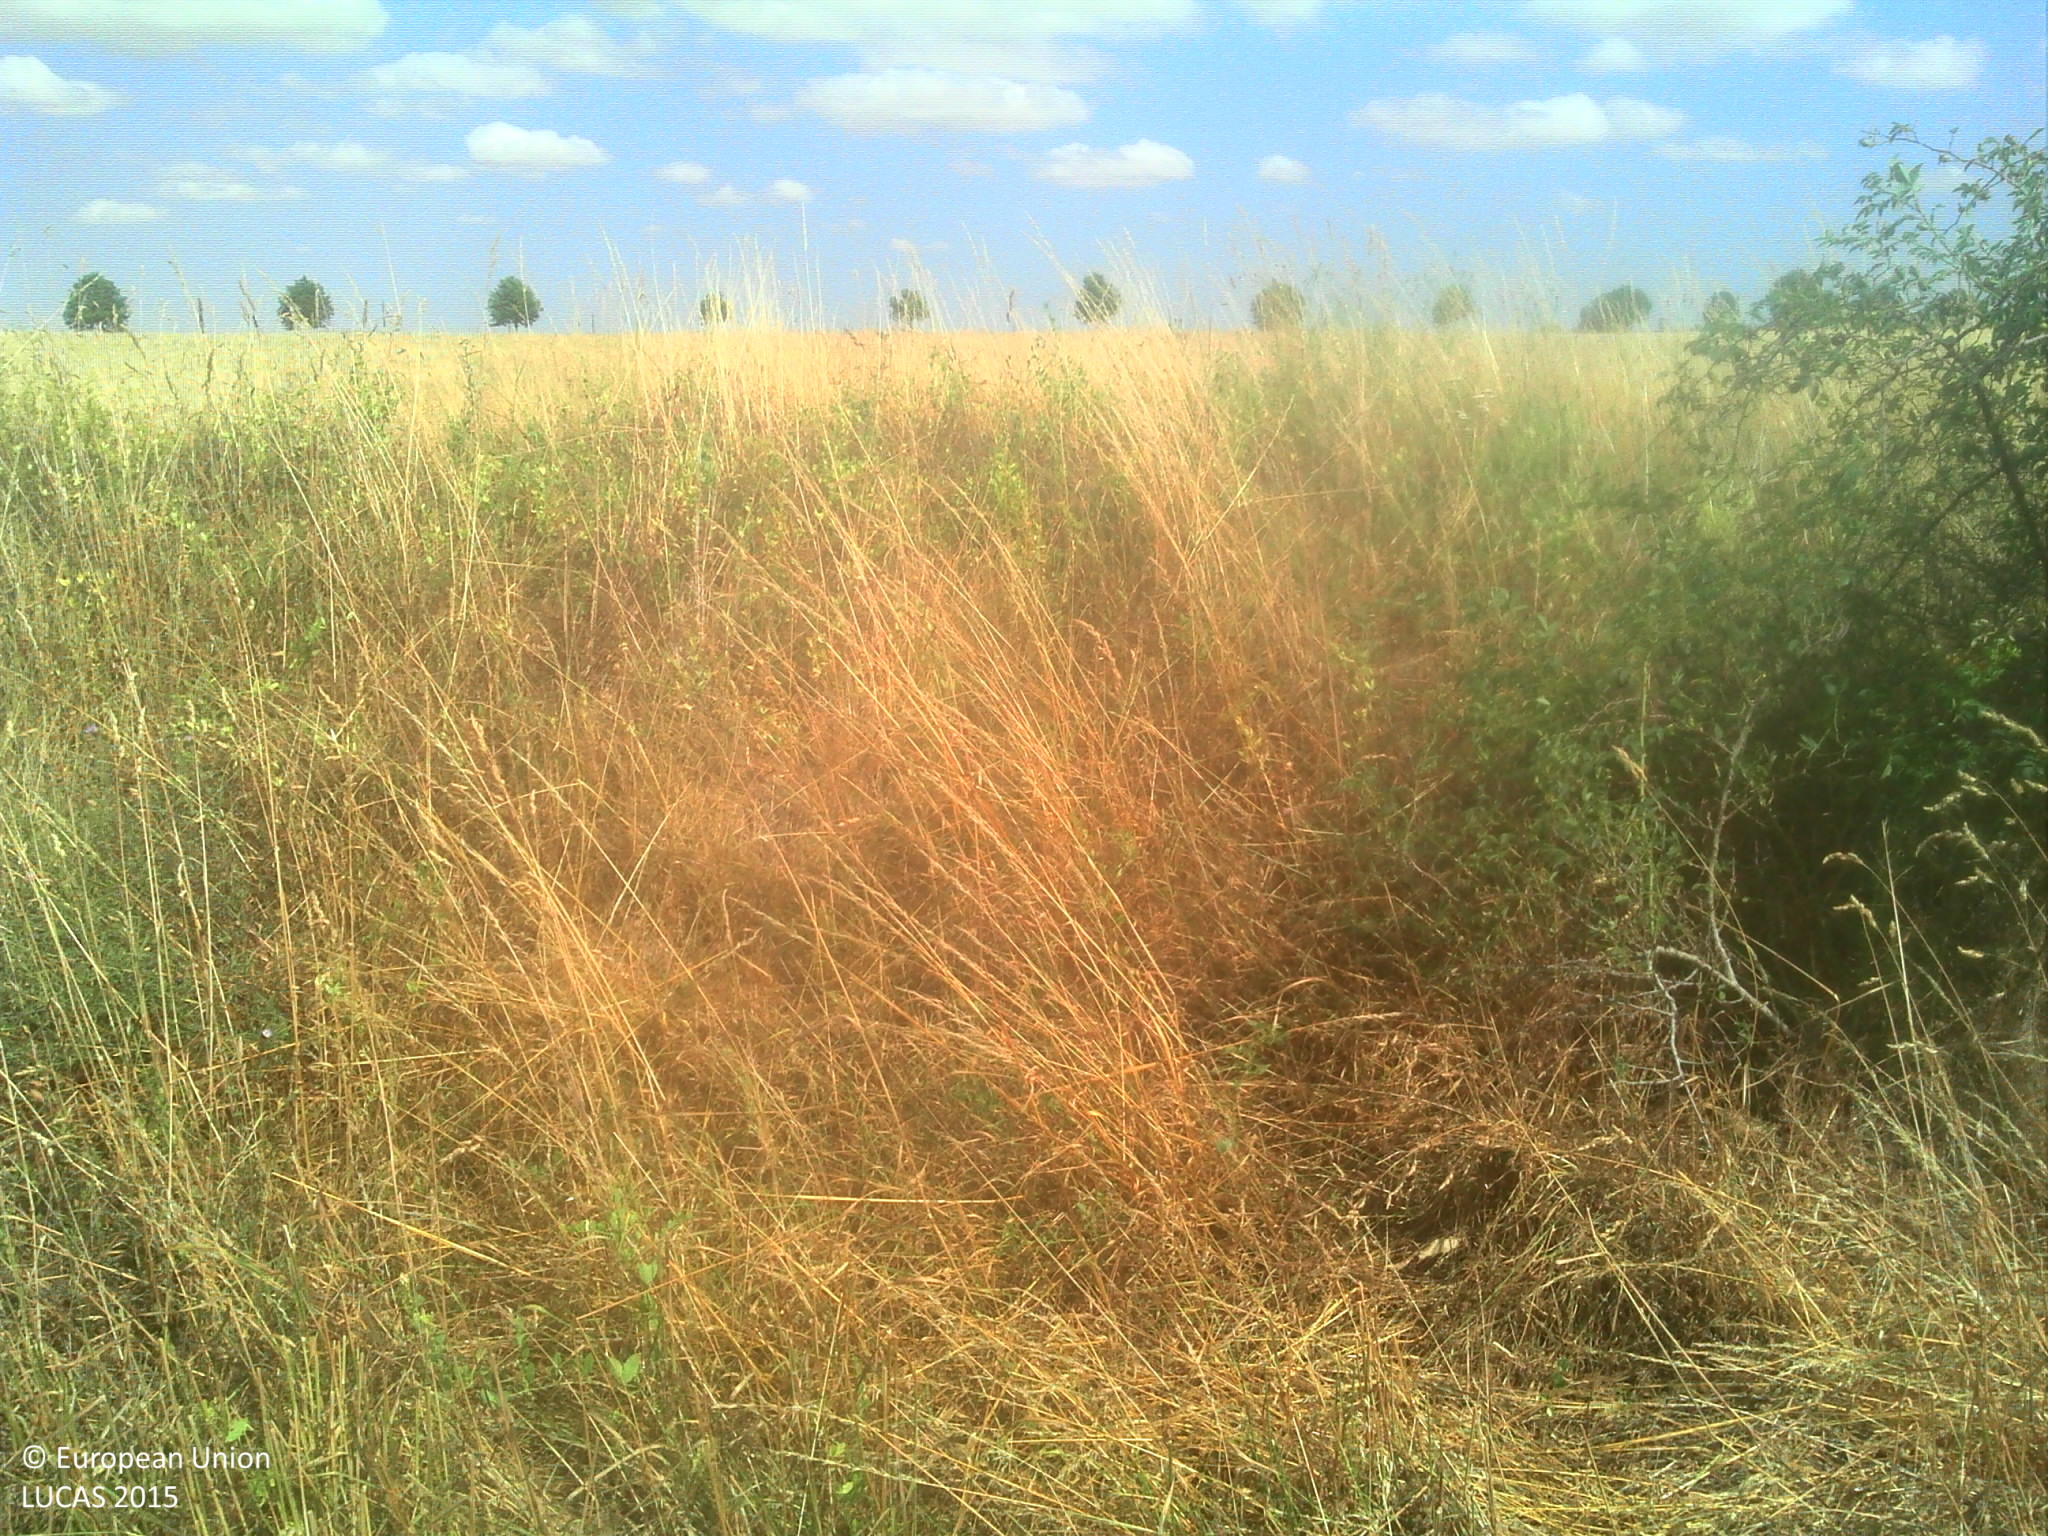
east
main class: Cropland
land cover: Rape and turnip rape
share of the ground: > 75 %
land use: Agriculture (excluding fallow land and kitchen gardens)
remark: Harvested field
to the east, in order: Rape and turnip rape; Managed hedges; Tracks; Grassland without tree/shrub cover; Lines of trees; Grass margins; Ditches and canals; Grass margins; Paved roads, cycling and walking lanes; Grass margins; Durum wheat
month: July
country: FR
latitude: 47.9530
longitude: 1.3197
